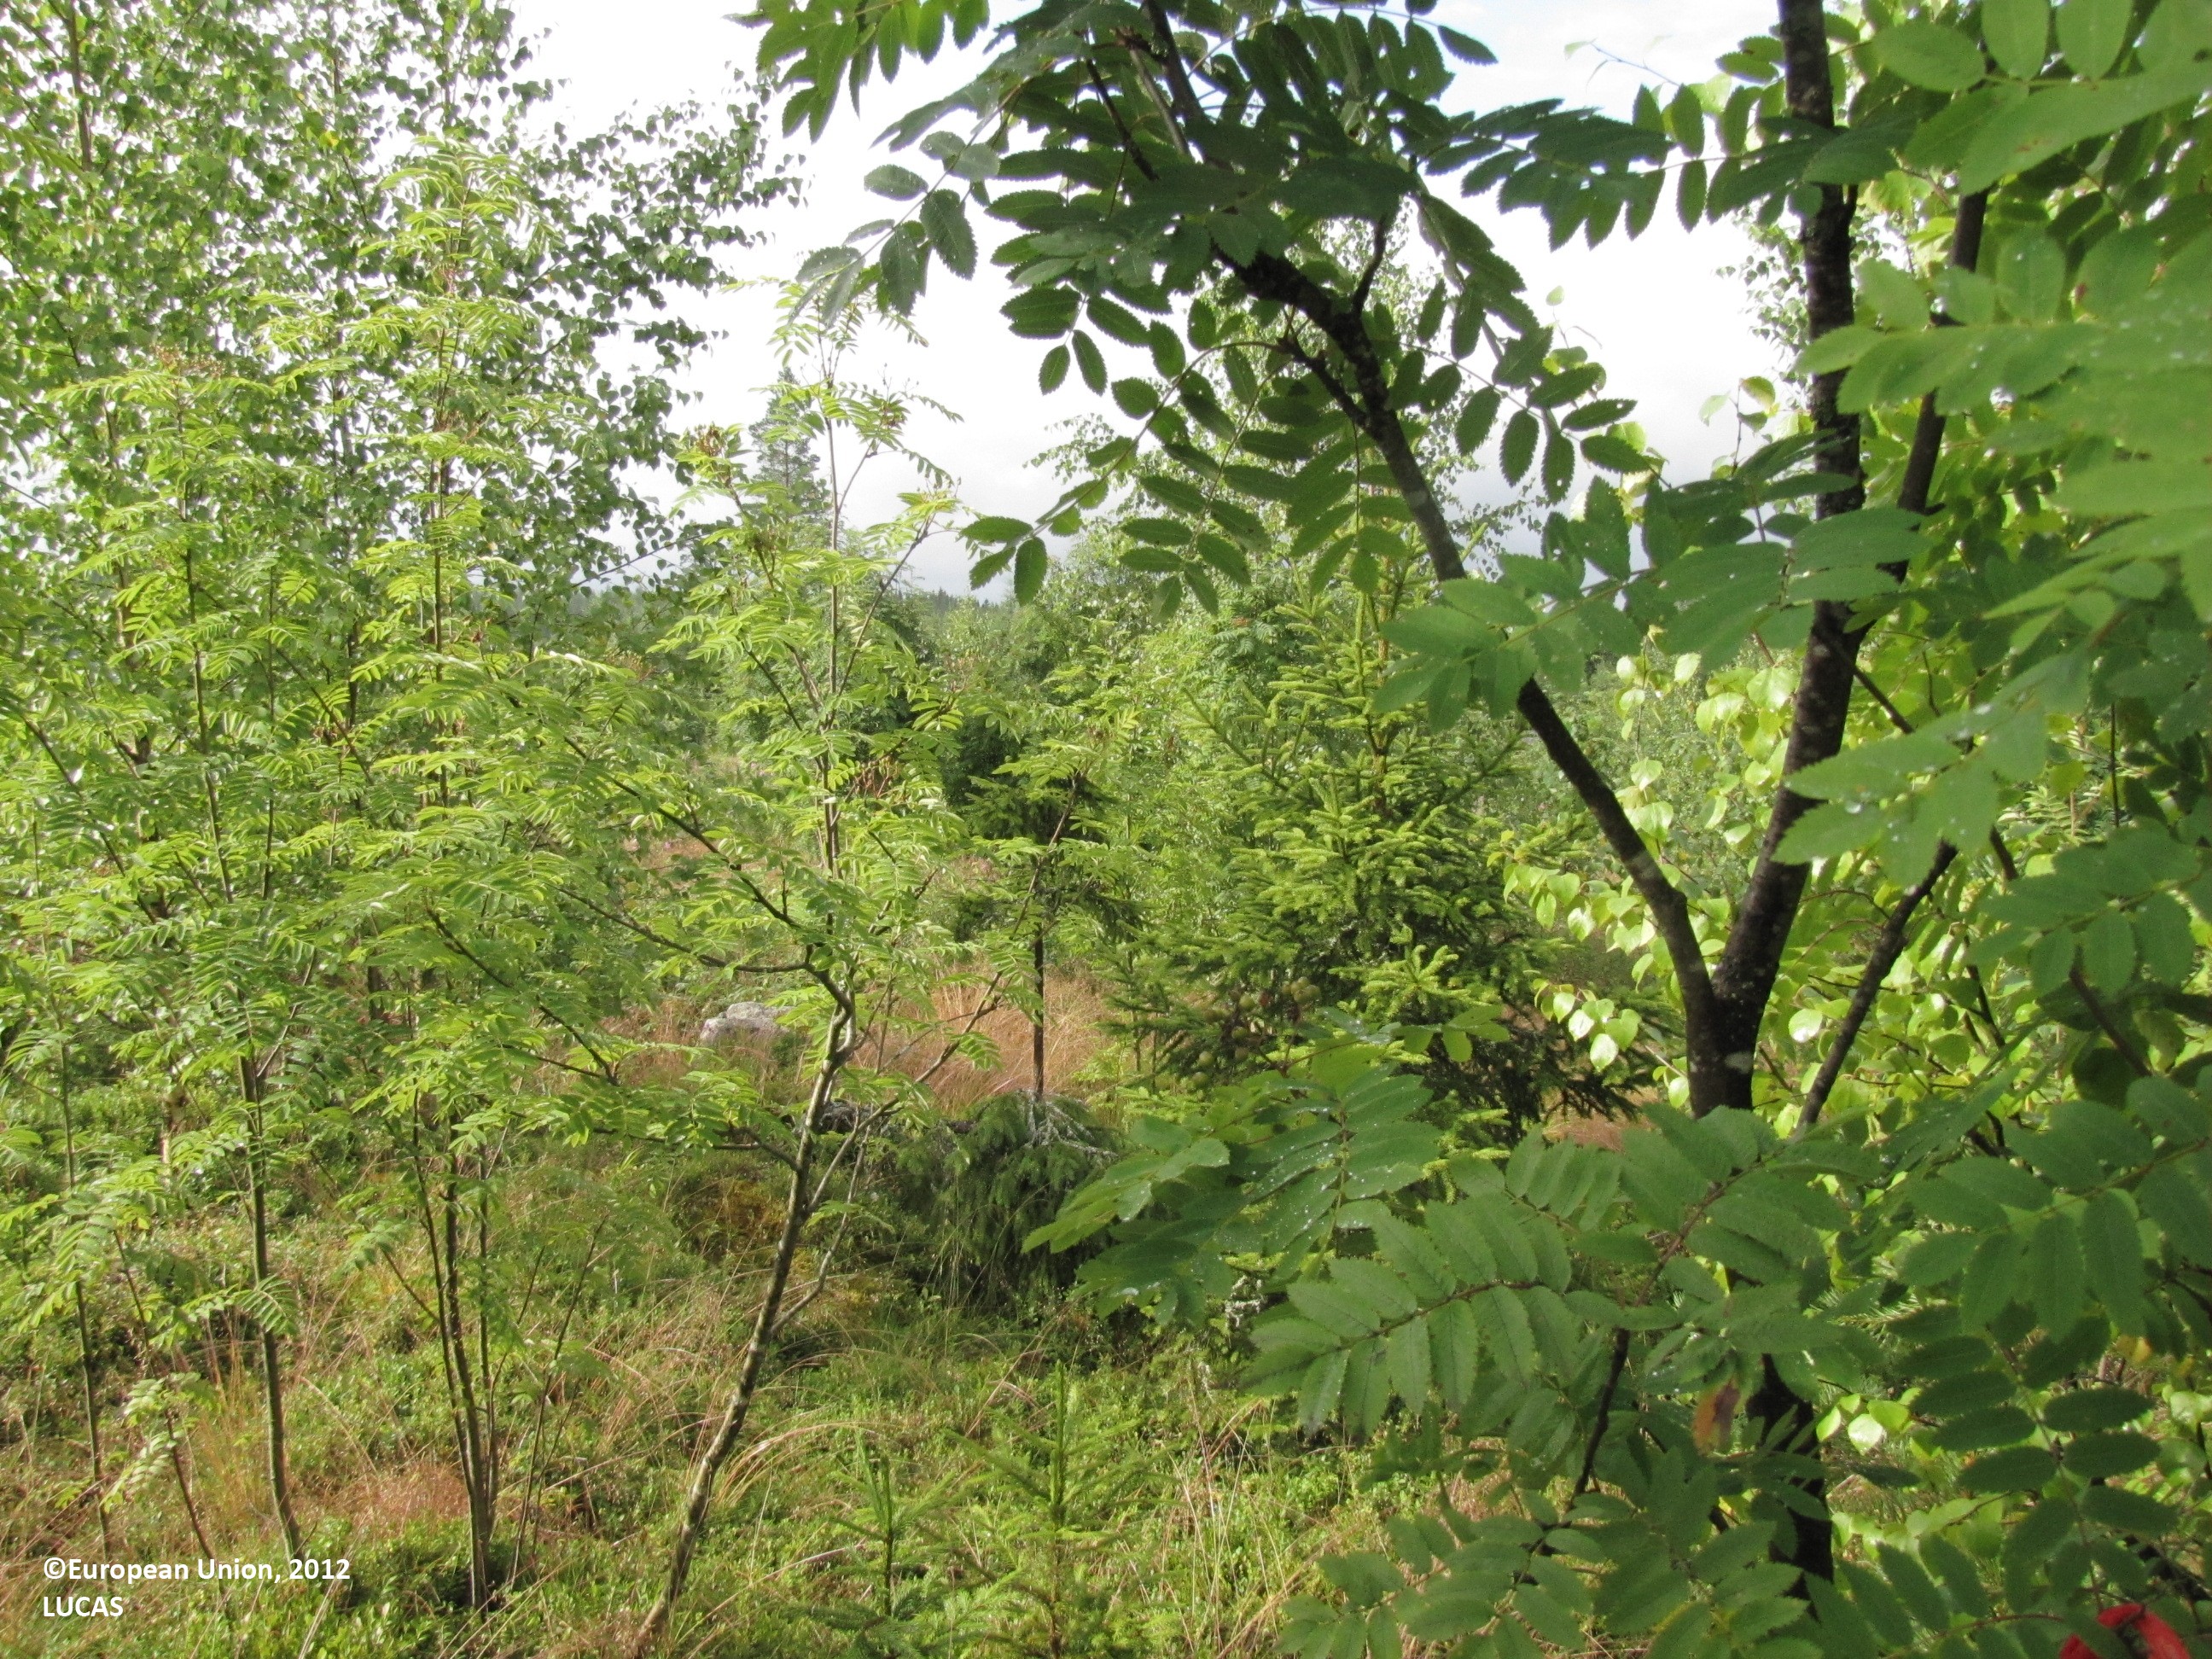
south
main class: Woodland
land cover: Broadleaved woodland
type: boreal forest
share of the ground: 50 - 75 %
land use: Forestry
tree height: < 5 m
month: July
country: FI
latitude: 62.1540
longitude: 23.0199
